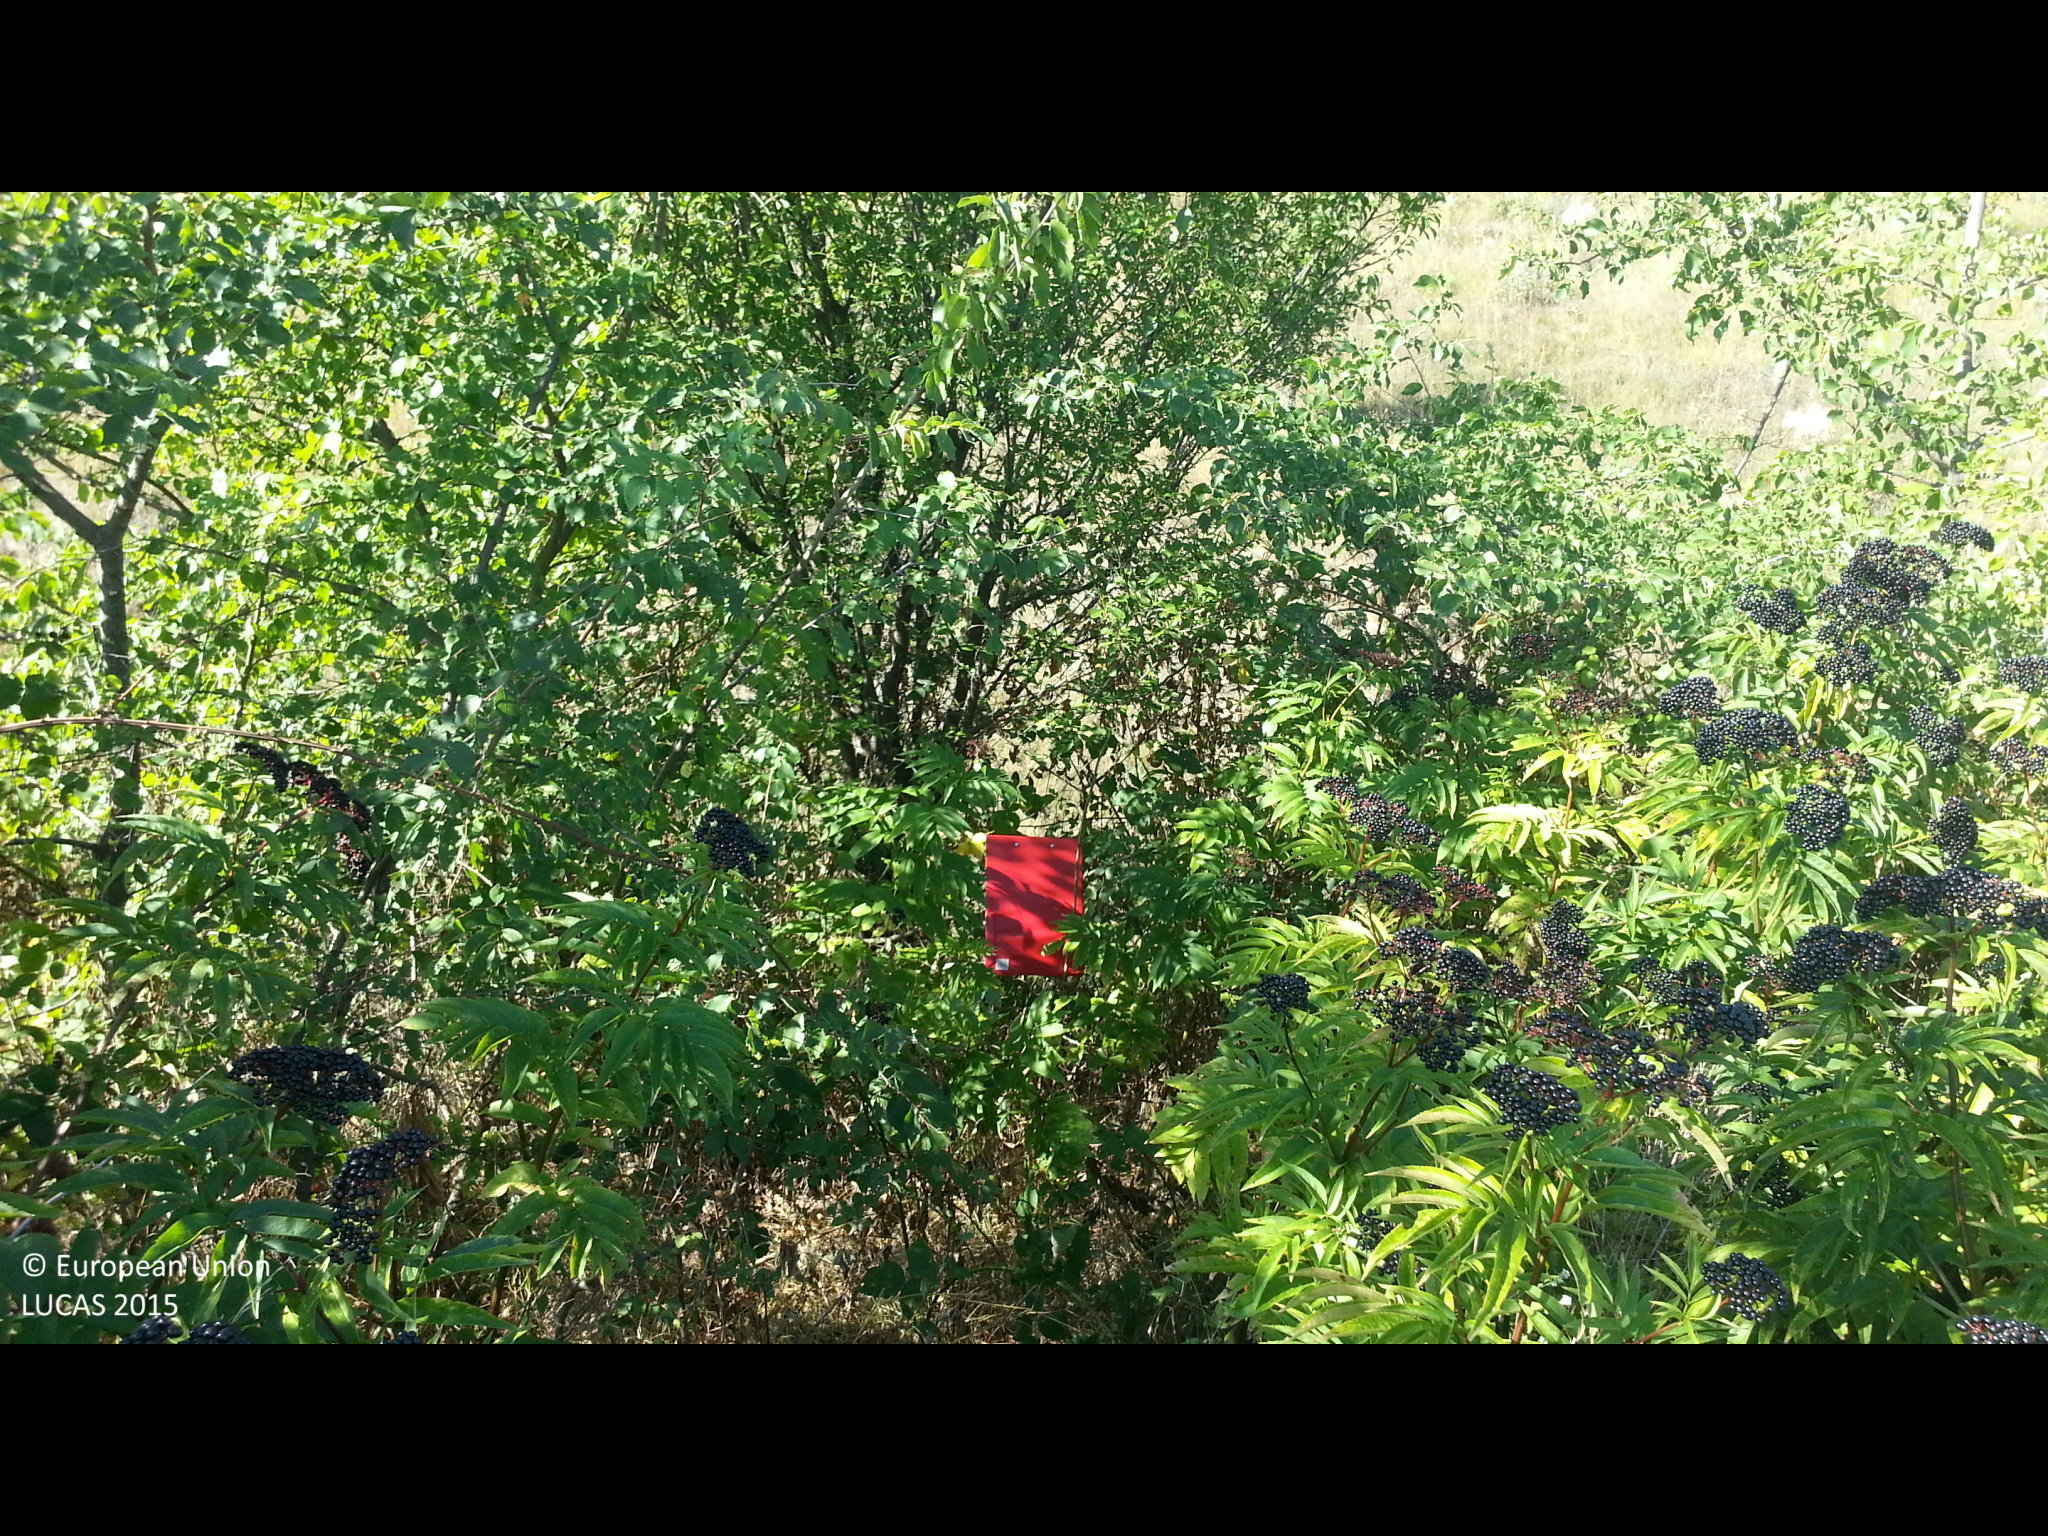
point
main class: Shrubland
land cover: Shrubland with sparse tree cover
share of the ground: > 75 %
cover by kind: shrubs 95 %, broadleaved forest trees 5 %
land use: Semi-natural and natural areas not in use
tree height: < 5 m
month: September
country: BG
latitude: 42.1873
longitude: 23.0663
